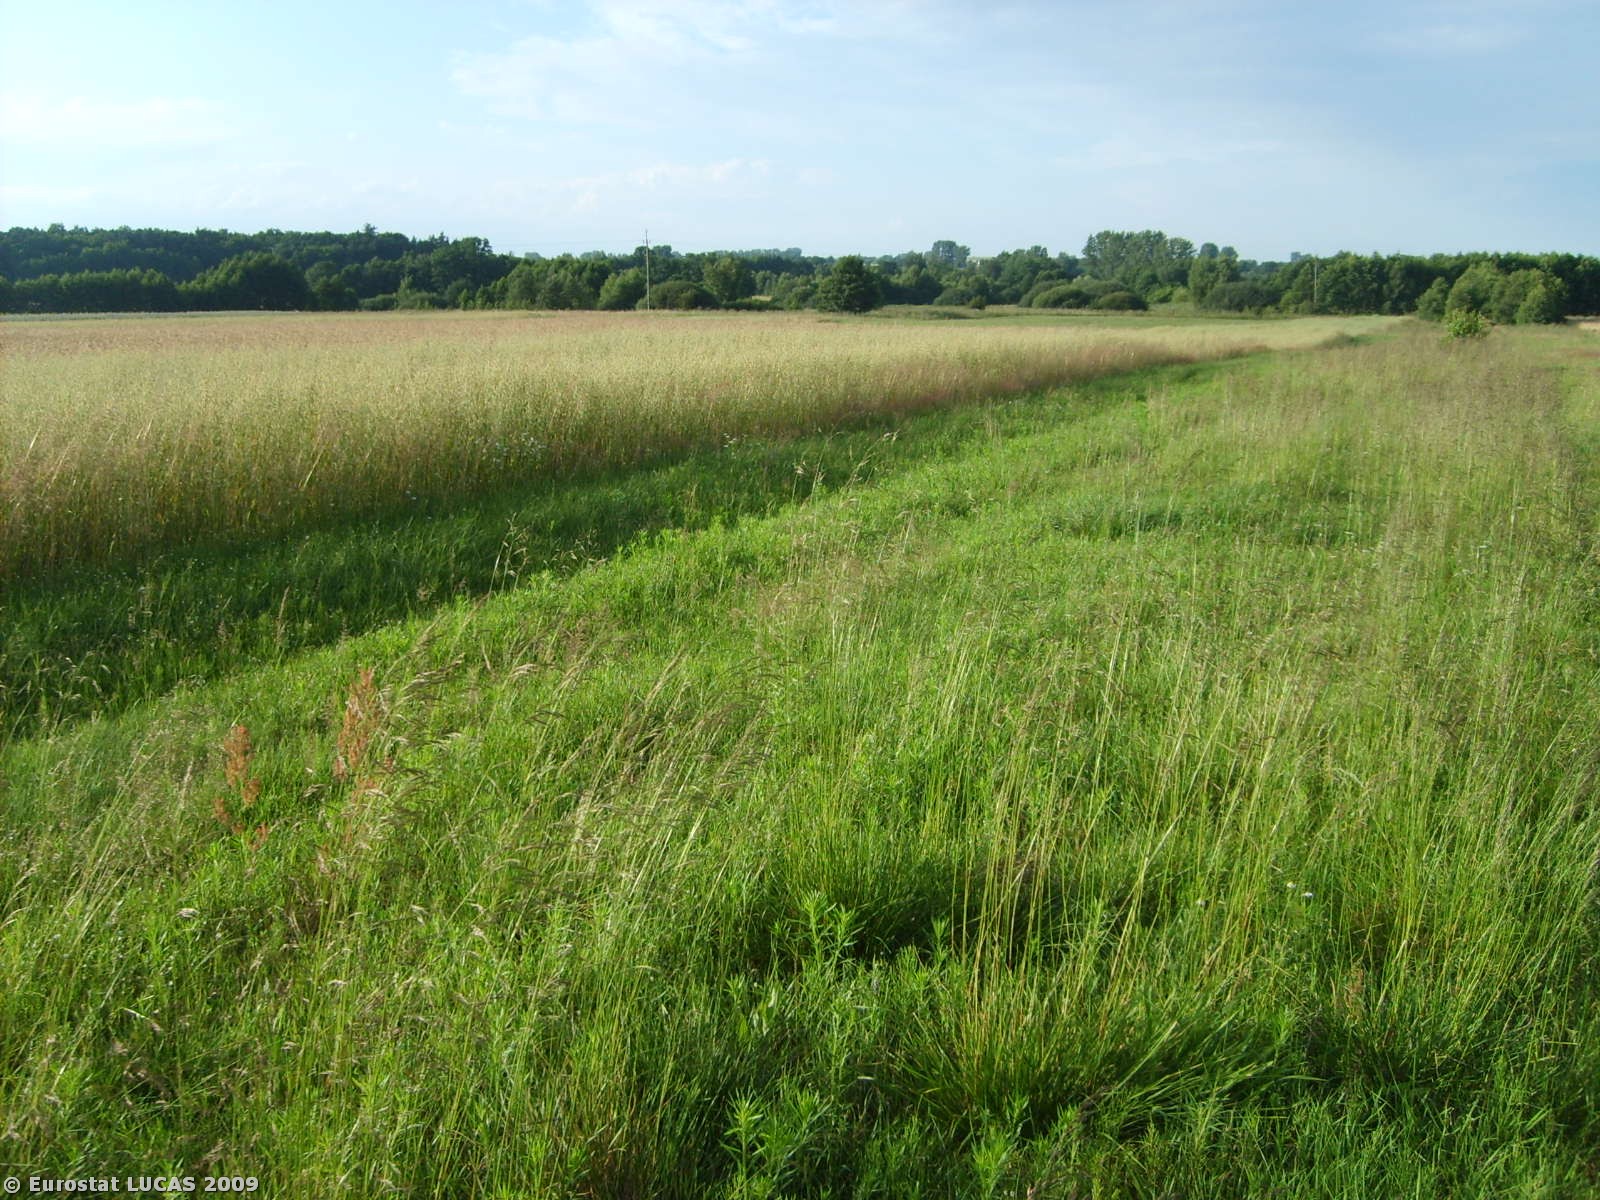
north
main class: Grassland
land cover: Grassland without tree/shrub cover
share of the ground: > 75 %
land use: Agriculture (excluding fallow land and kitchen gardens)
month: July
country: PL
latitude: 50.2688
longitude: 20.6034
